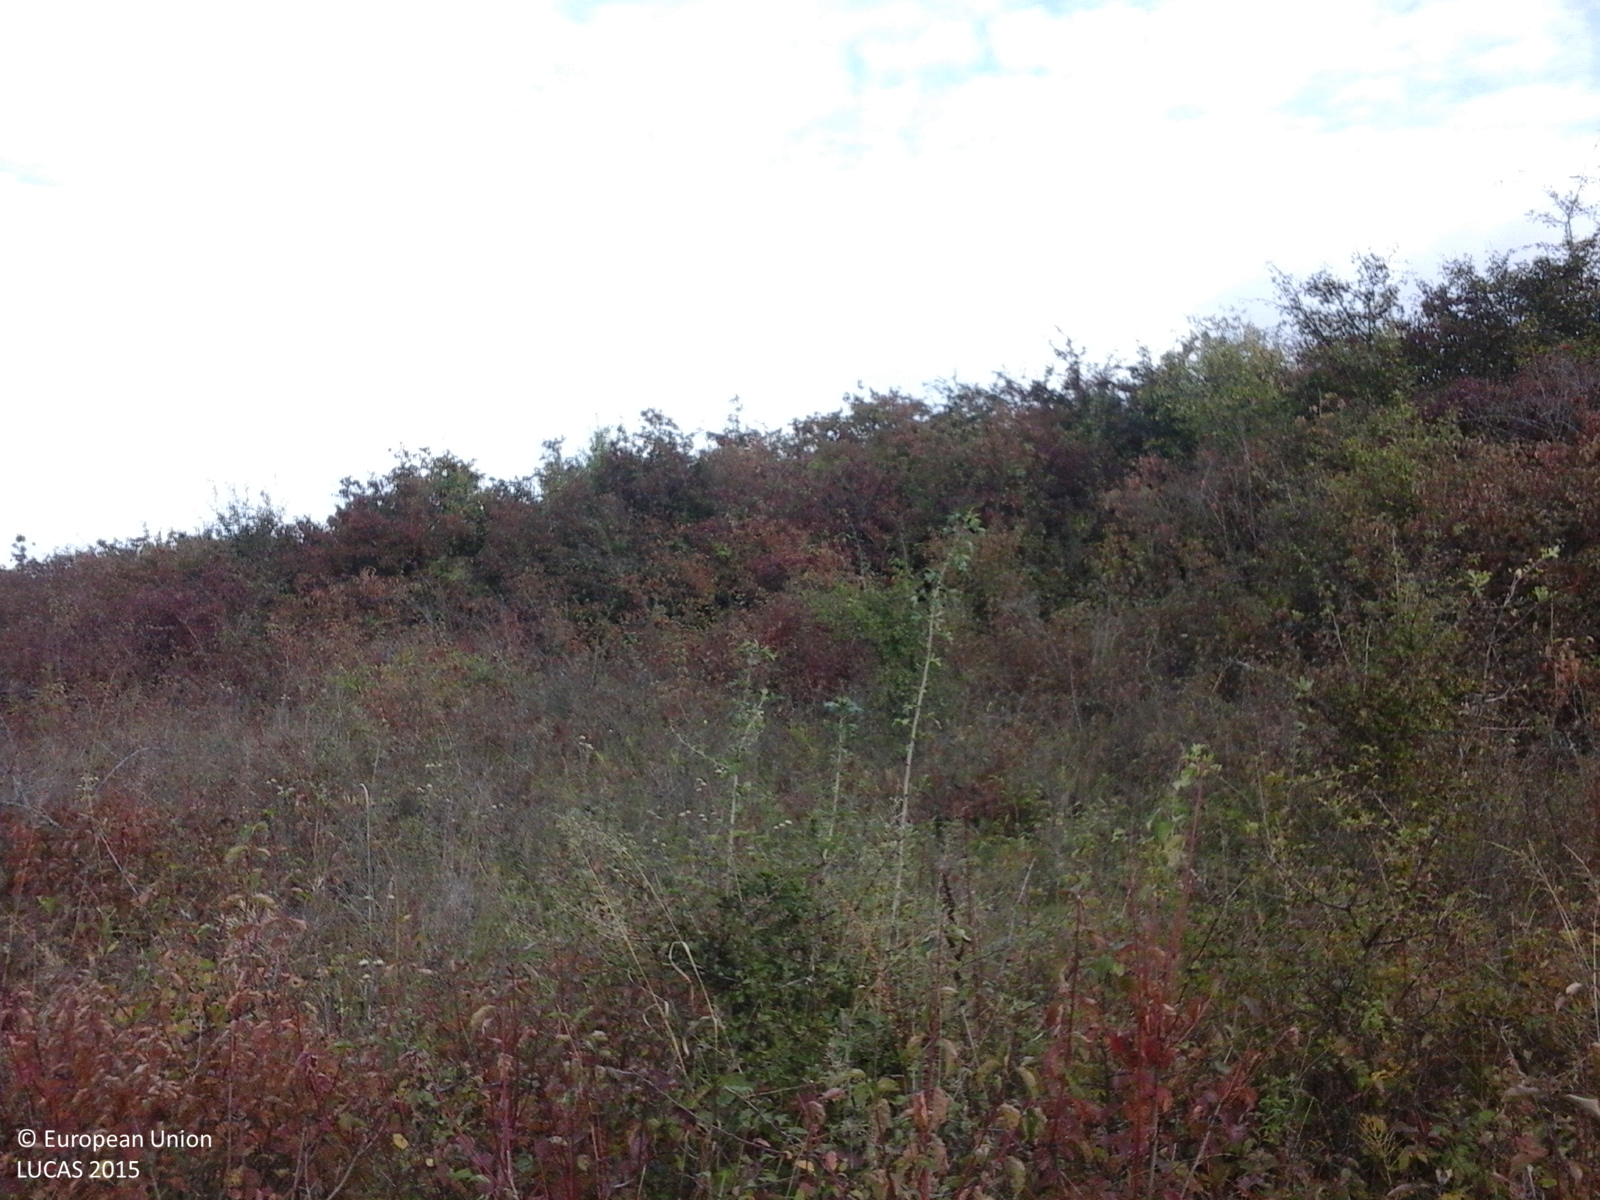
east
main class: Grassland
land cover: Grassland with sparse tree/shrub cover
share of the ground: > 75 %
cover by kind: herbaceous plants 85 %, shrubs 10 %, broadleaved forest trees 5 %
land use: Fallow land
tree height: < 5 m
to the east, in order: Grassland with sparse tree/shrub cover; Shrubland with sparse tree cover; Spontaneously vegetated surfaces; Sunflower; Shrubland with sparse tree cover; Grassland without tree/shrub cover; Common wheat
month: October
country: RO
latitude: 46.3834
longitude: 24.3466
